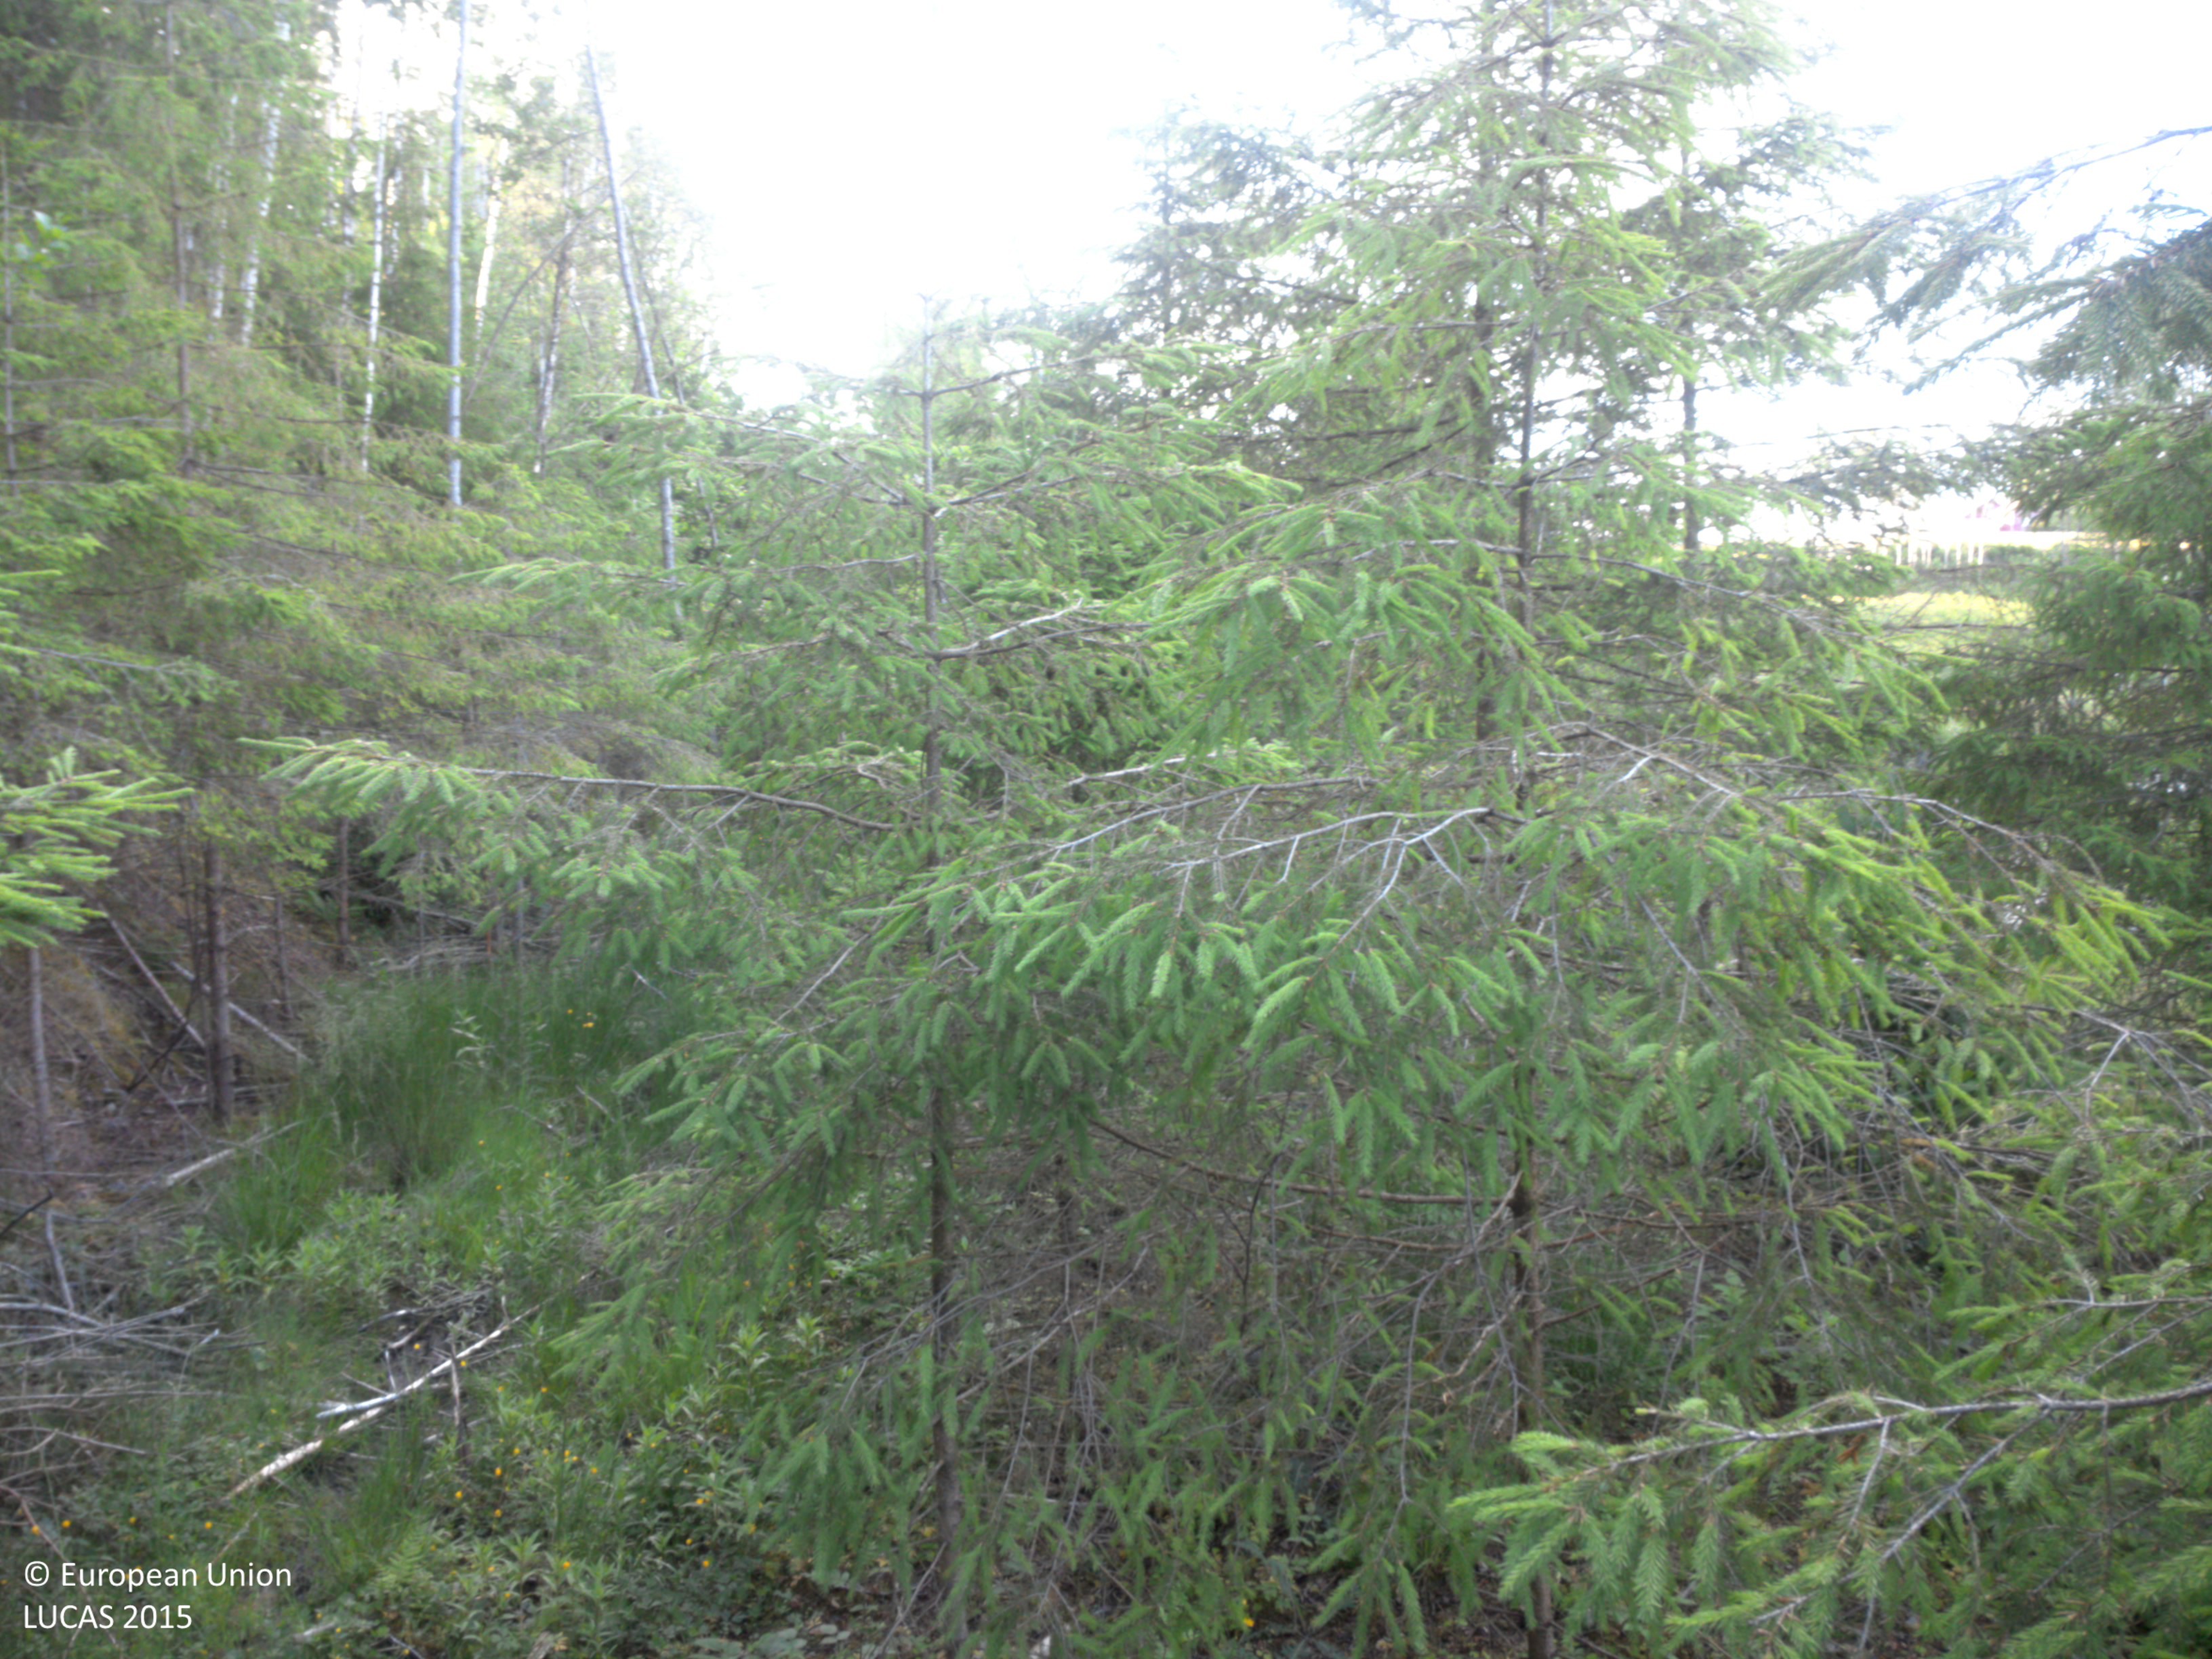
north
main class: Woodland
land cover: Spruce dominated mixed woodland
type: boreal forest
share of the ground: 25 - 50 %
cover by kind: herbaceous plants 40 %, coniferous forest trees 30 %, broadleaved forest trees 15 %, shrubs 15 %
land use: Forestry
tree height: < 5 m
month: June
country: SE
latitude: 58.8224
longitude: 11.5378
